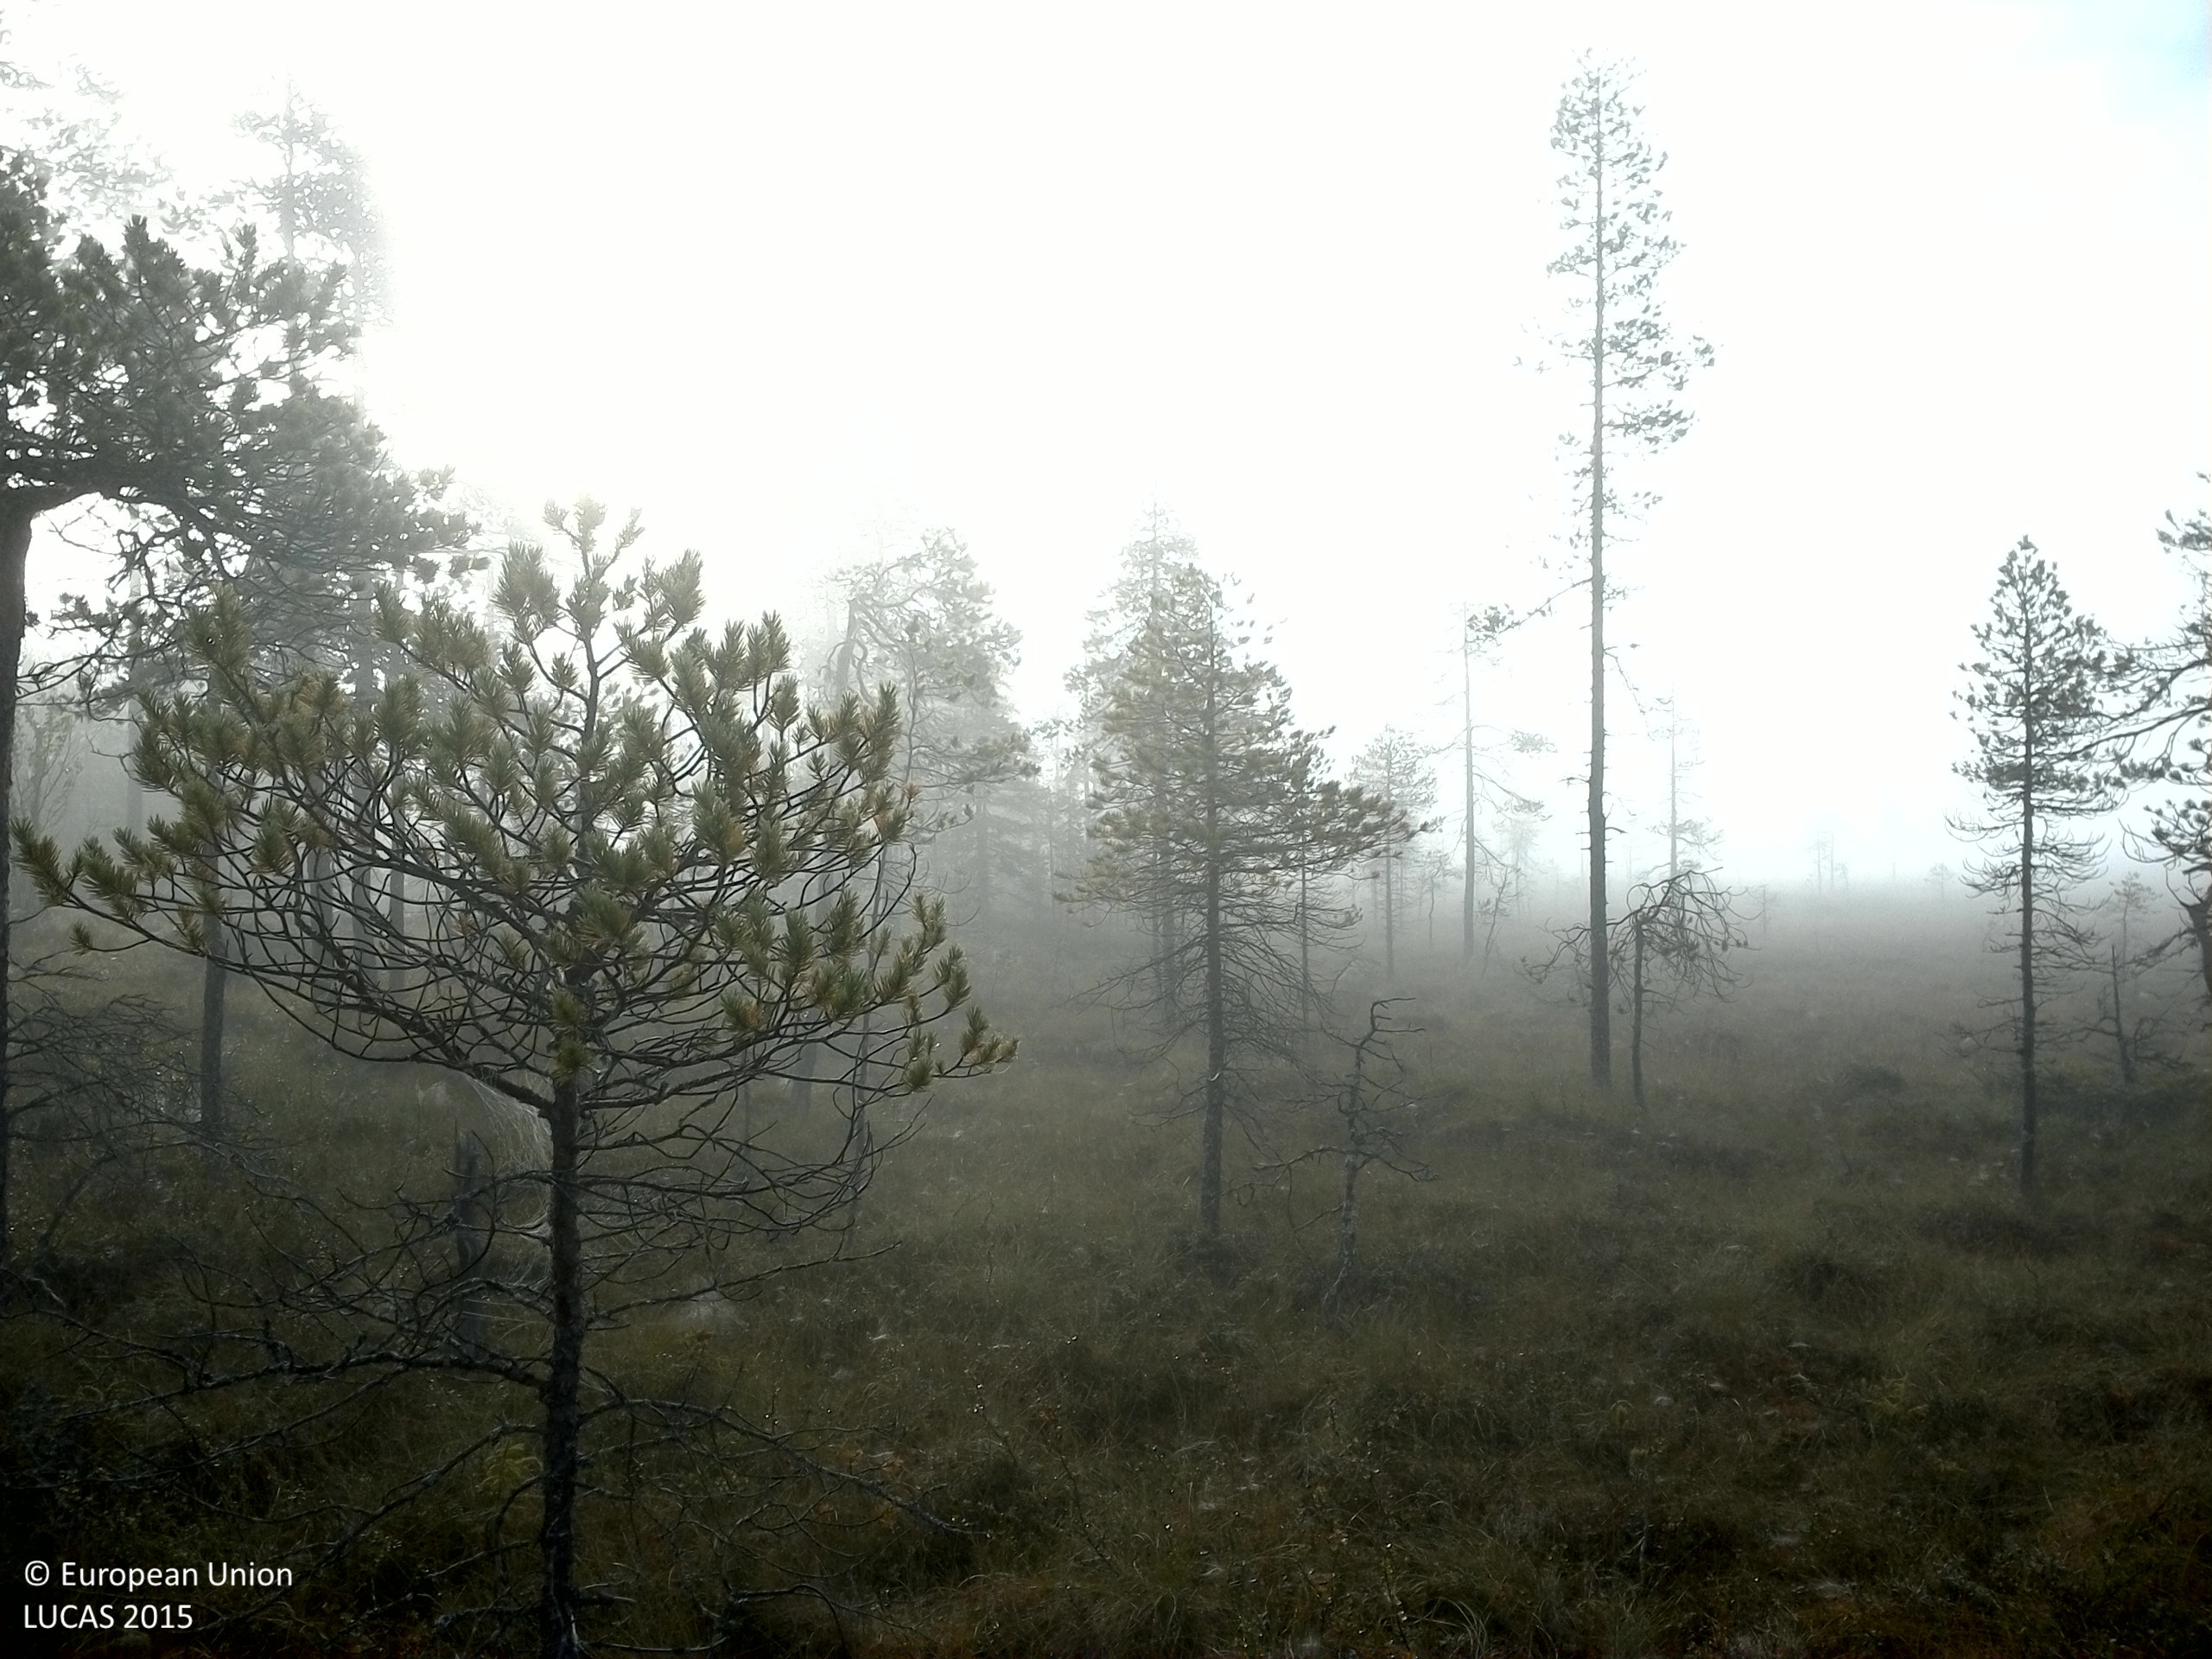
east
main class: Woodland
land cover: Pine dominated coniferous woodland
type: boreal forest
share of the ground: 10 - 25 %
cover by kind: lichens and mosses 40 %, herbaceous plants 25 %, shrubs 20 %, coniferous forest trees 15 %
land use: Semi-natural and natural areas not in use
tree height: < 5 m
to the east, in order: Pine dominated coniferous woodland; Spruce dominated mixed woodland; Pine dominated coniferous woodland
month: September
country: SE
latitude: 64.0143
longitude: 17.6418
